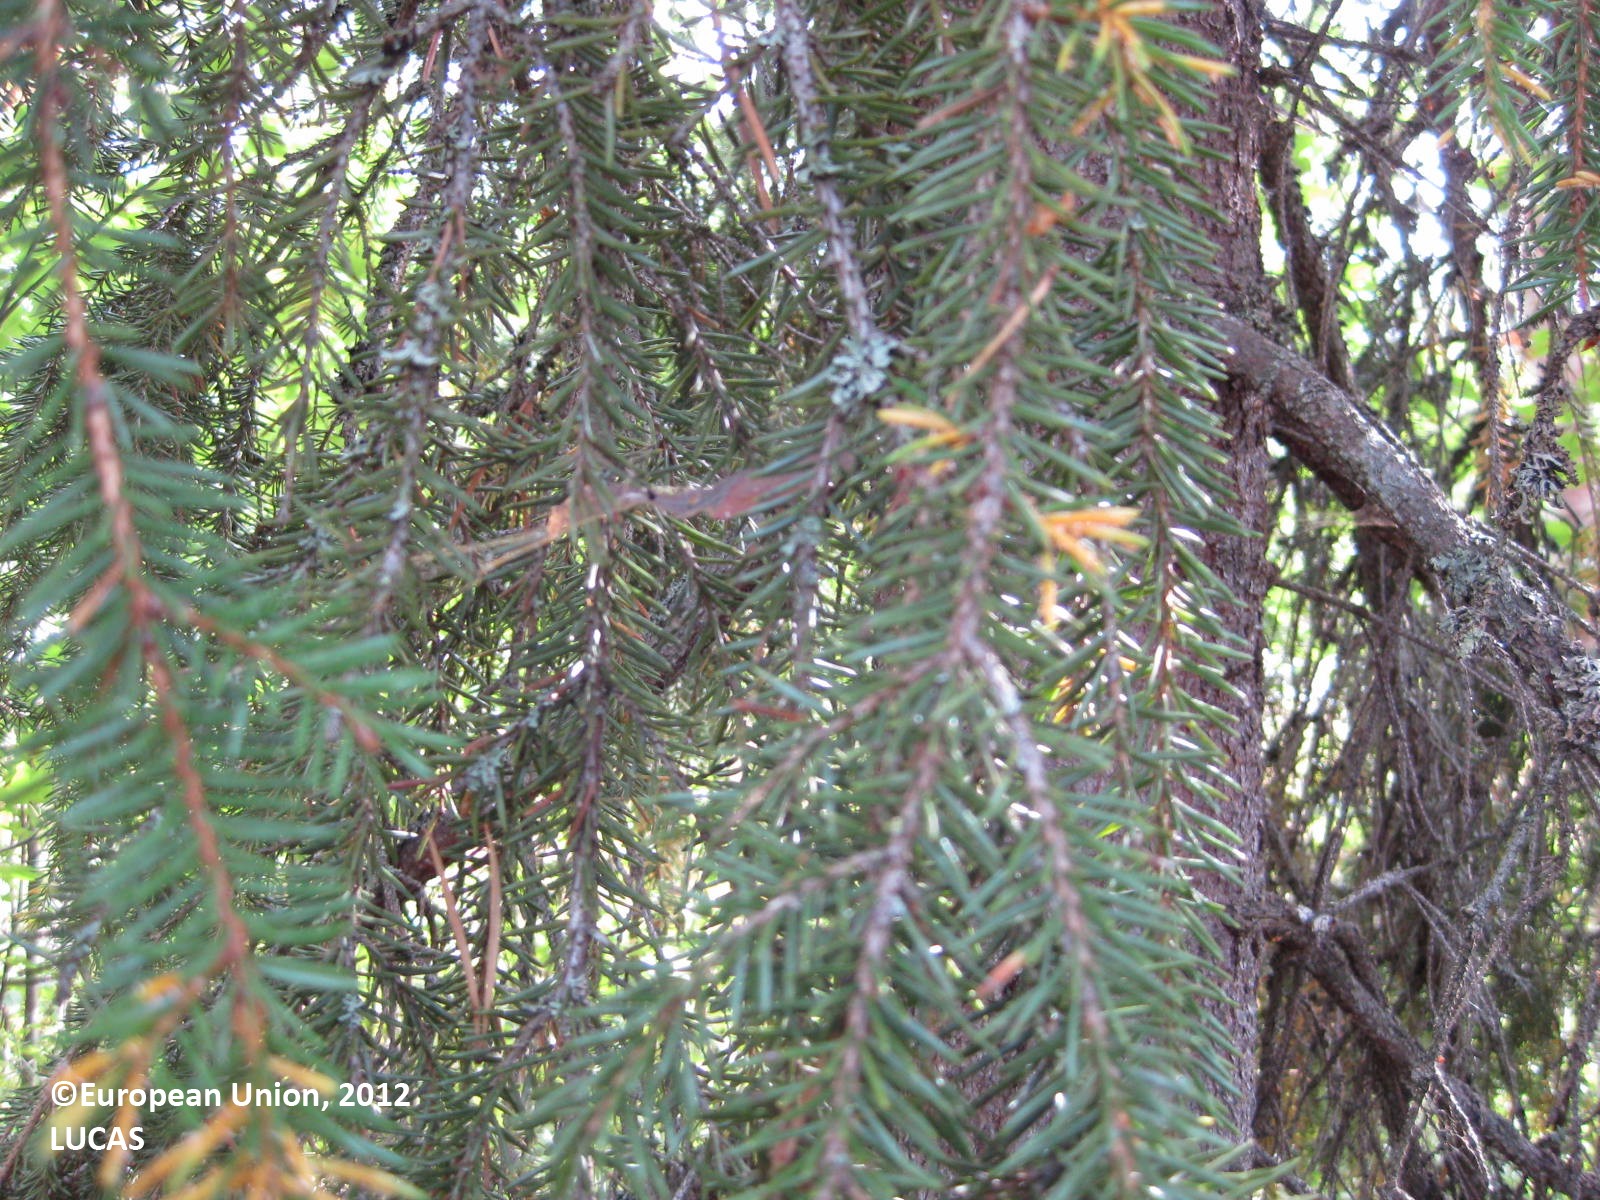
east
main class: Woodland
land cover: Pine dominated mixed woodland
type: boreal forest
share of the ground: > 75 %
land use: Forestry
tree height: > 5 m
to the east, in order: Pine dominated mixed woodland; Broadleaved woodland; Ditches and canals; Spontaneously vegetated surfaces; Paved roads, cycling and walking lanes; Spontaneously vegetated surfaces; Broadleaved woodland; Pine dominated coniferous woodland; Pine dominated mixed woodland; Ditches and canals; Broadleaved woodland; Ditches and canals; Spontaneously vegetated surfaces; Ditches and canals; Spontaneously vegetated surfaces; Broadleaved woodland; Ditches and canals; Broadleaved woodland; Pine dominated mixed woodland; Ditches and canals; Pine dominated mixed woodland; Tracks; Pine dominated coniferous woodland
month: August
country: FI
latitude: 66.2445
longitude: 28.8722
